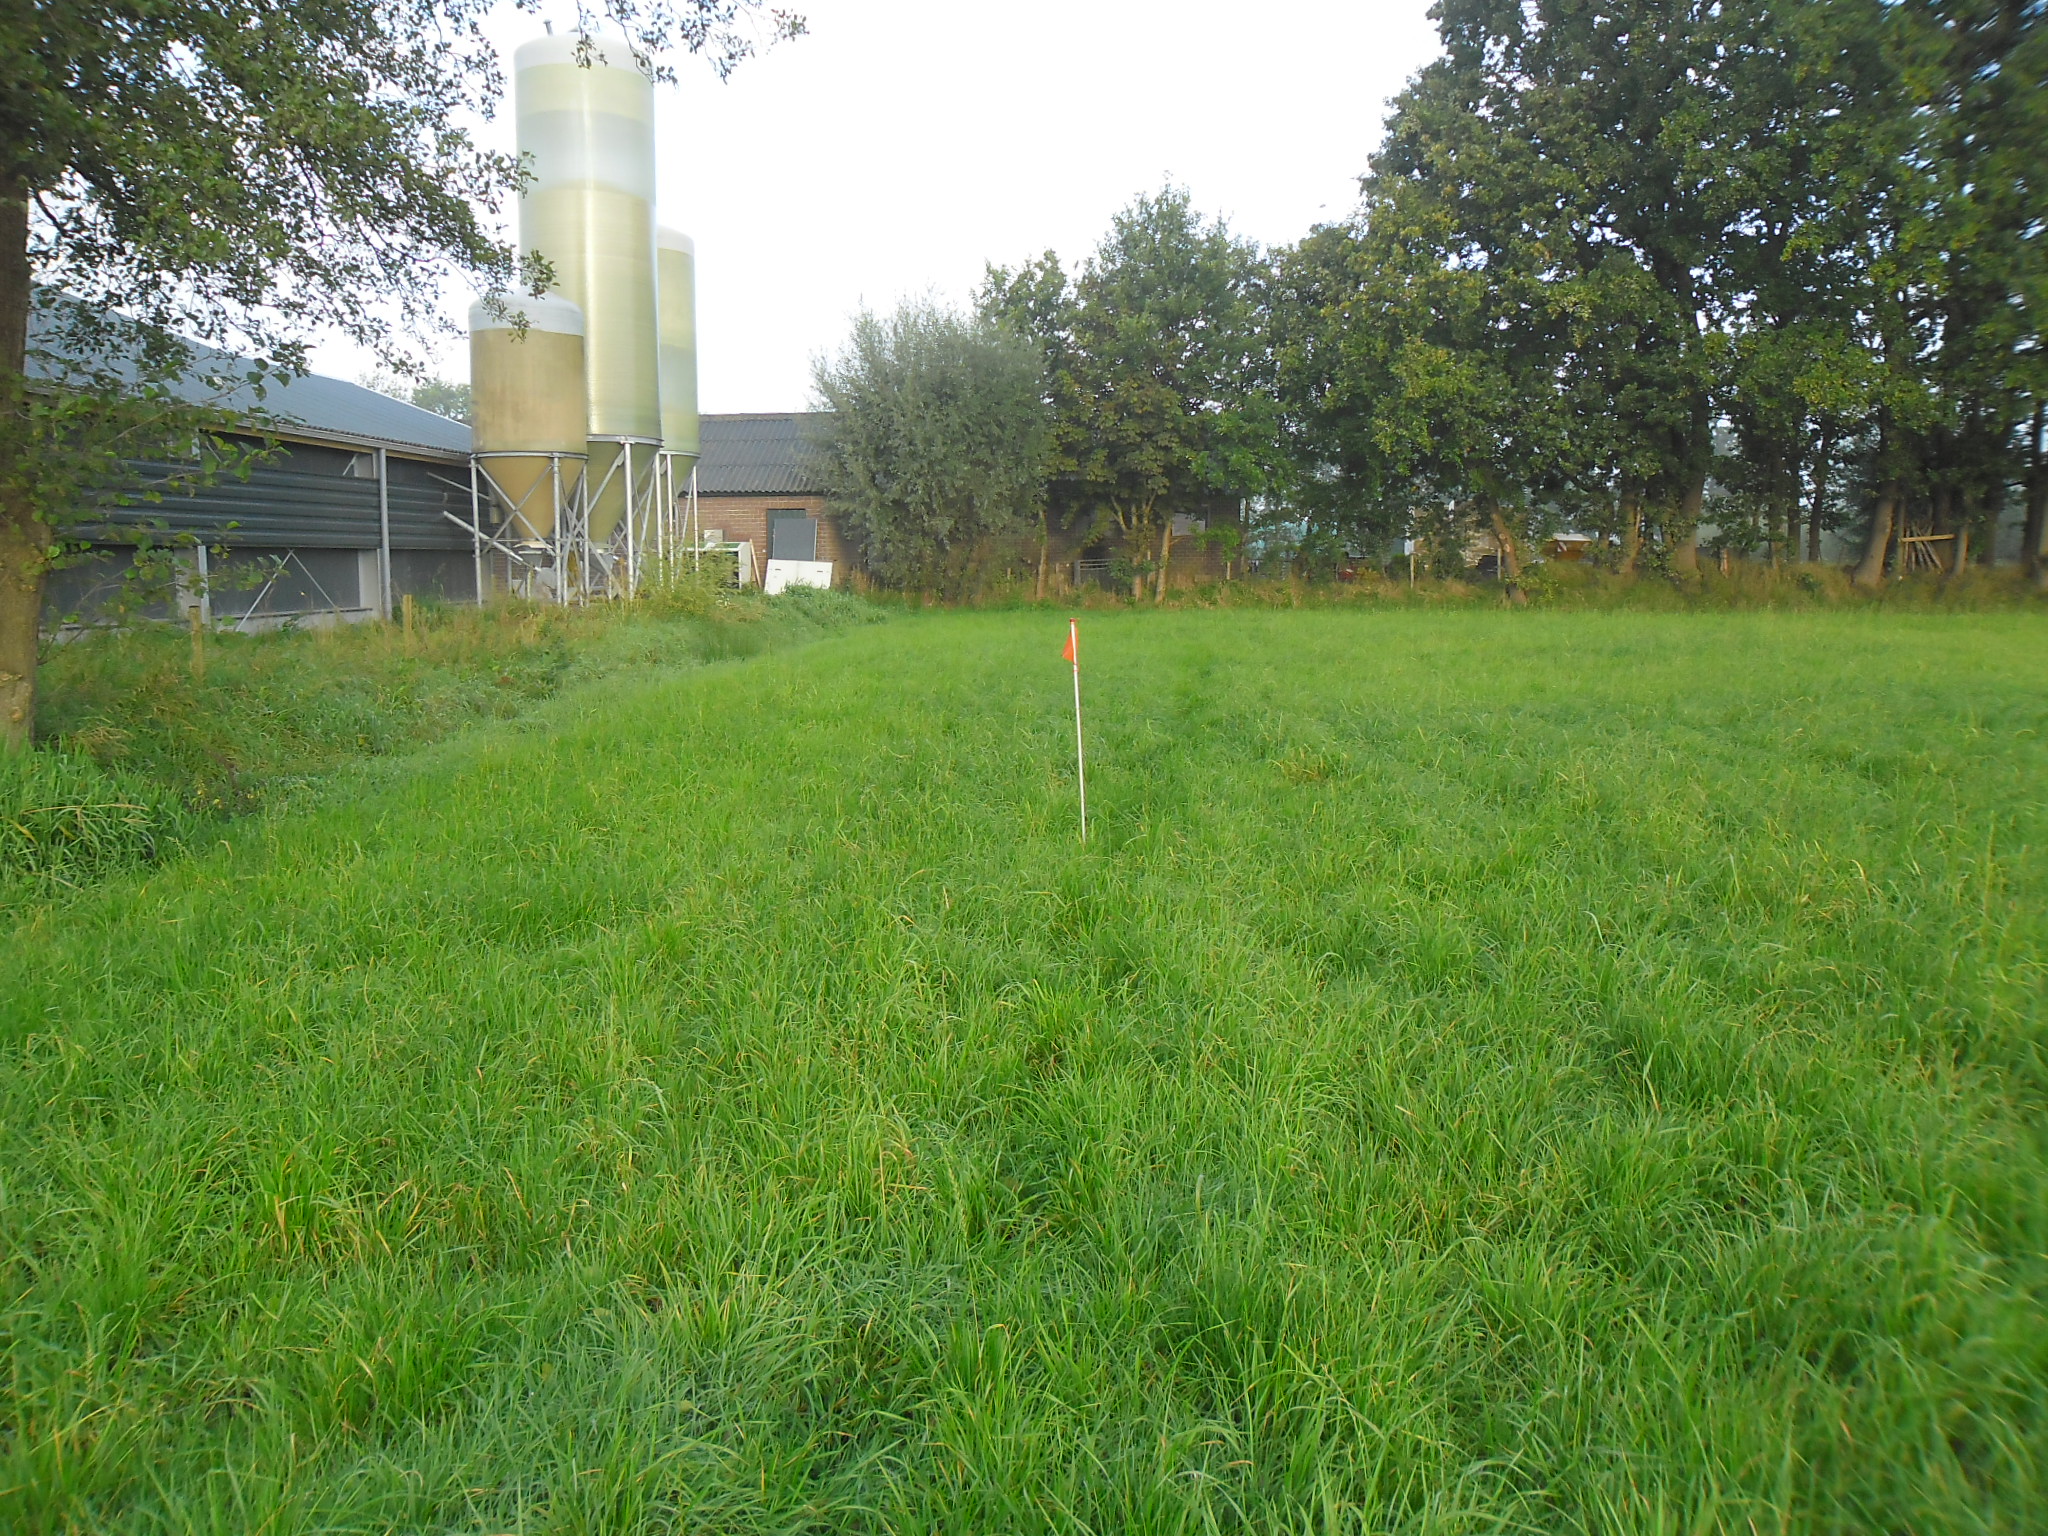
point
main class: Grassland
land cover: Grassland without tree/shrub cover
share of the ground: > 75 %
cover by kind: herbaceous plants 100 %
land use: Agriculture (excluding fallow land and kitchen gardens)
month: September
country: NL
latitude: 52.0590
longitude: 5.5207
